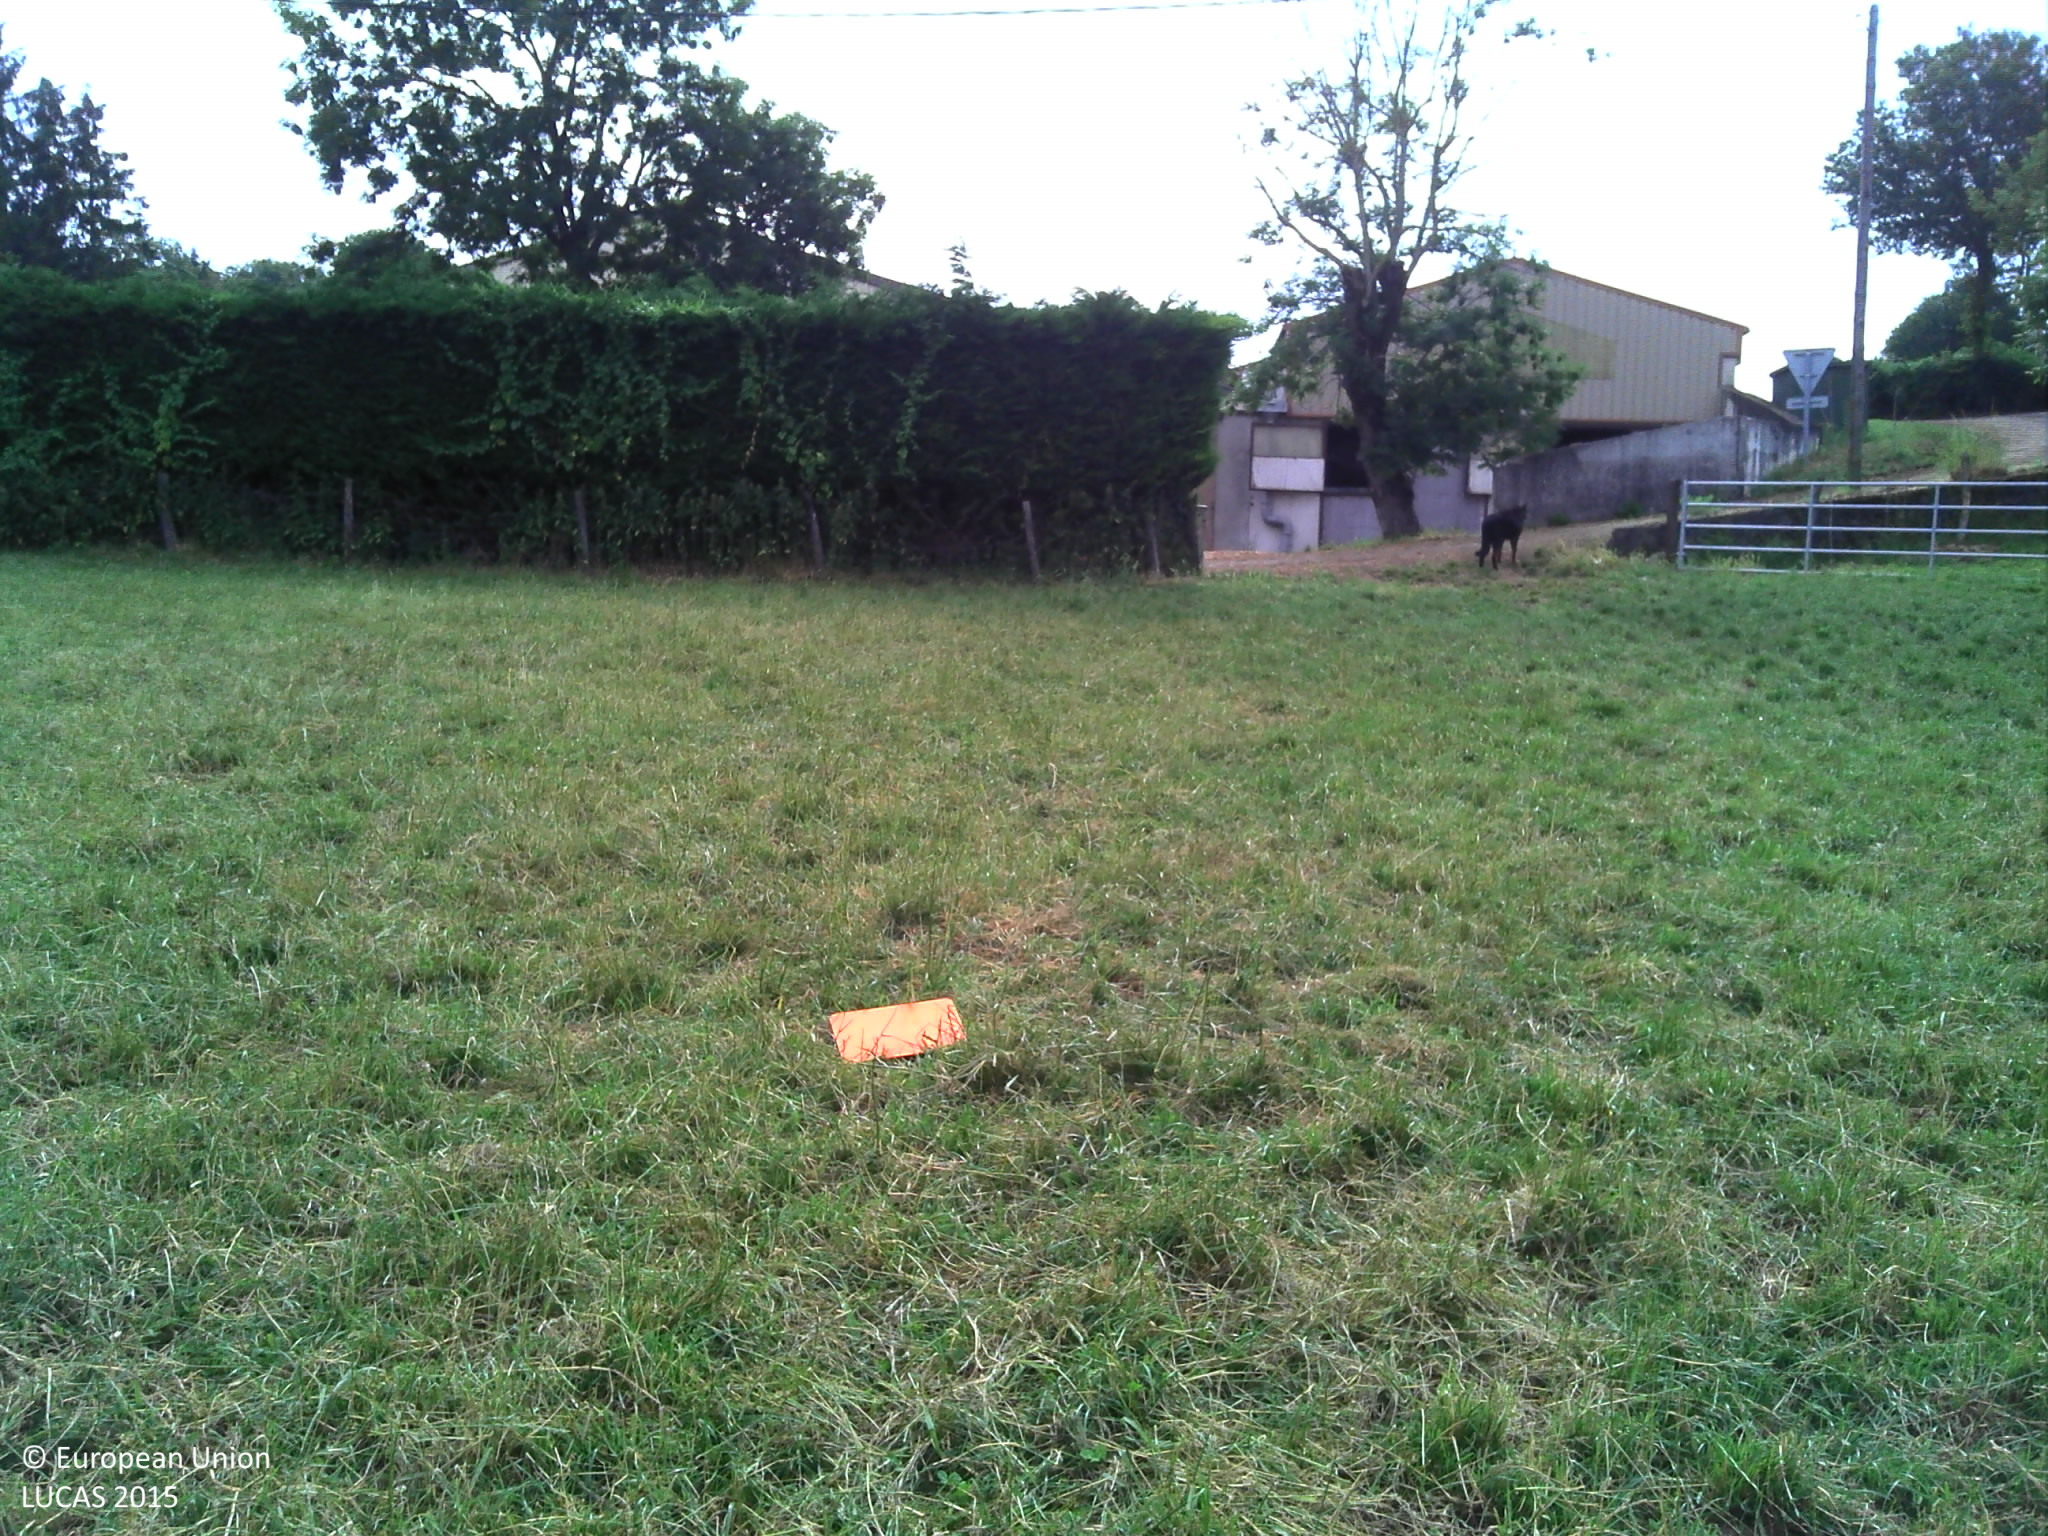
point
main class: Cropland
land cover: Temporary grasslands
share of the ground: > 75 %
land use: Agriculture (excluding fallow land and kitchen gardens)
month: June
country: FR
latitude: 44.2296
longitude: 2.5800
